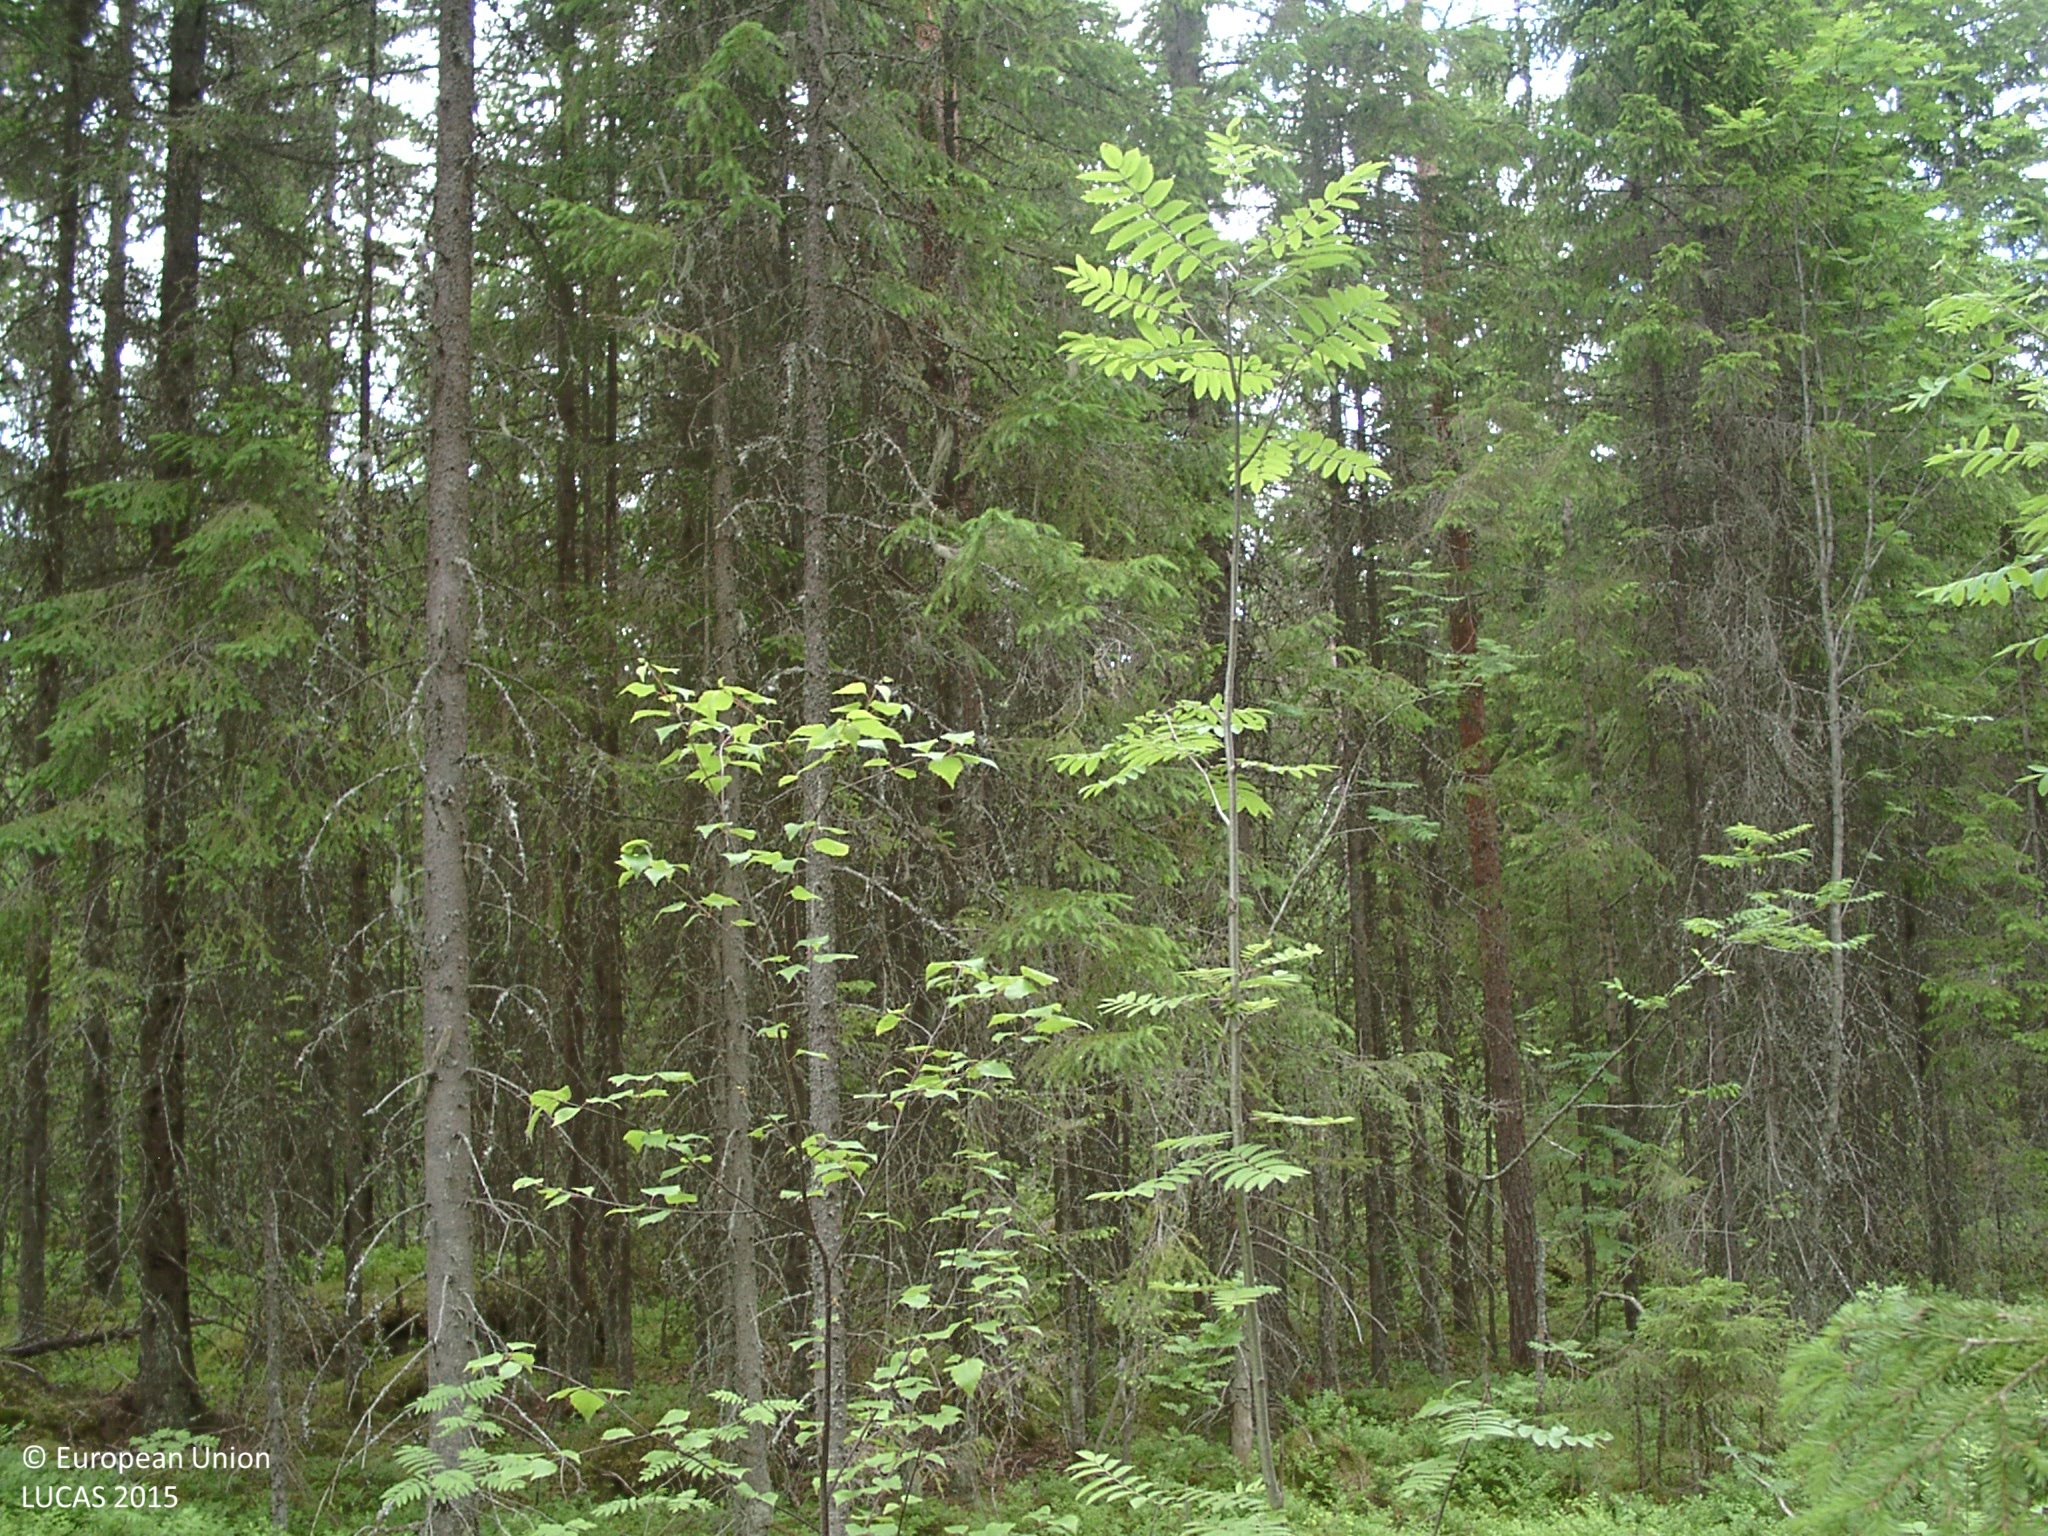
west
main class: Woodland
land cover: Pine dominated coniferous woodland
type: boreal forest
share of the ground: 50 - 75 %
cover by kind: coniferous forest trees 55 %, broadleaved forest trees 15 %, shrubs 15 %, herbaceous plants 10 %, lichens and mosses 5 %
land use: Forestry
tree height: > 5 m
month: July
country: FI
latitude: 62.0530
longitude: 25.3961
